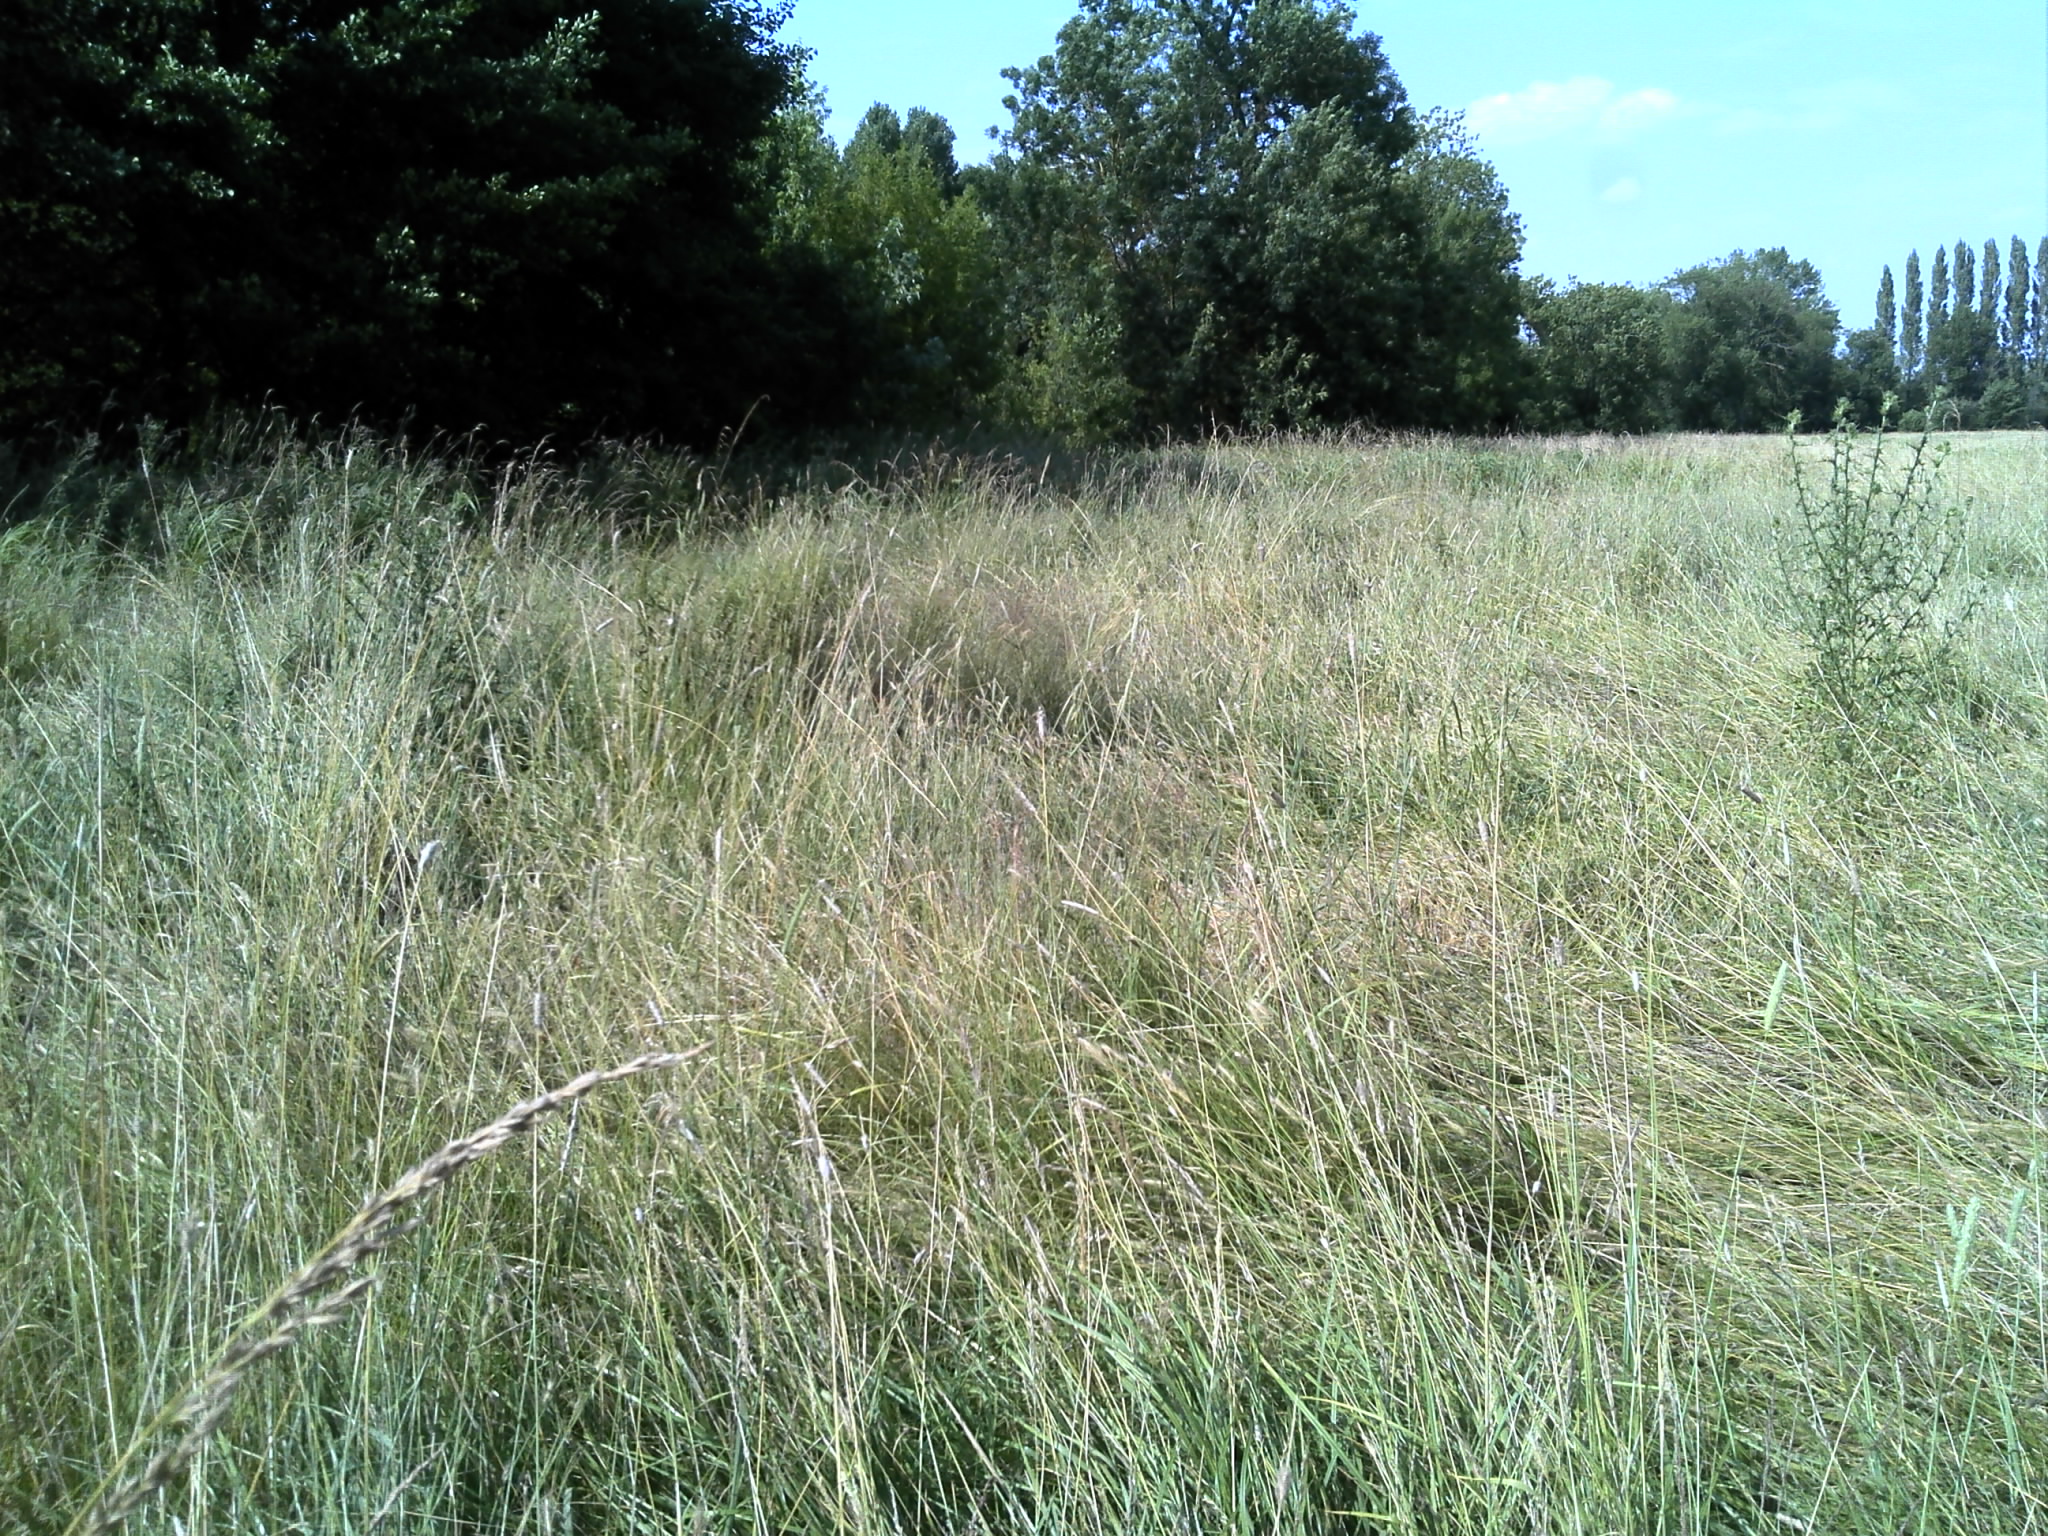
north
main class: Grassland
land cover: Grassland without tree/shrub cover
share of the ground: > 75 %
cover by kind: herbaceous plants 100 %
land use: Agriculture (excluding fallow land and kitchen gardens)
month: July
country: FR
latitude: 46.8021
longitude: 1.6429
